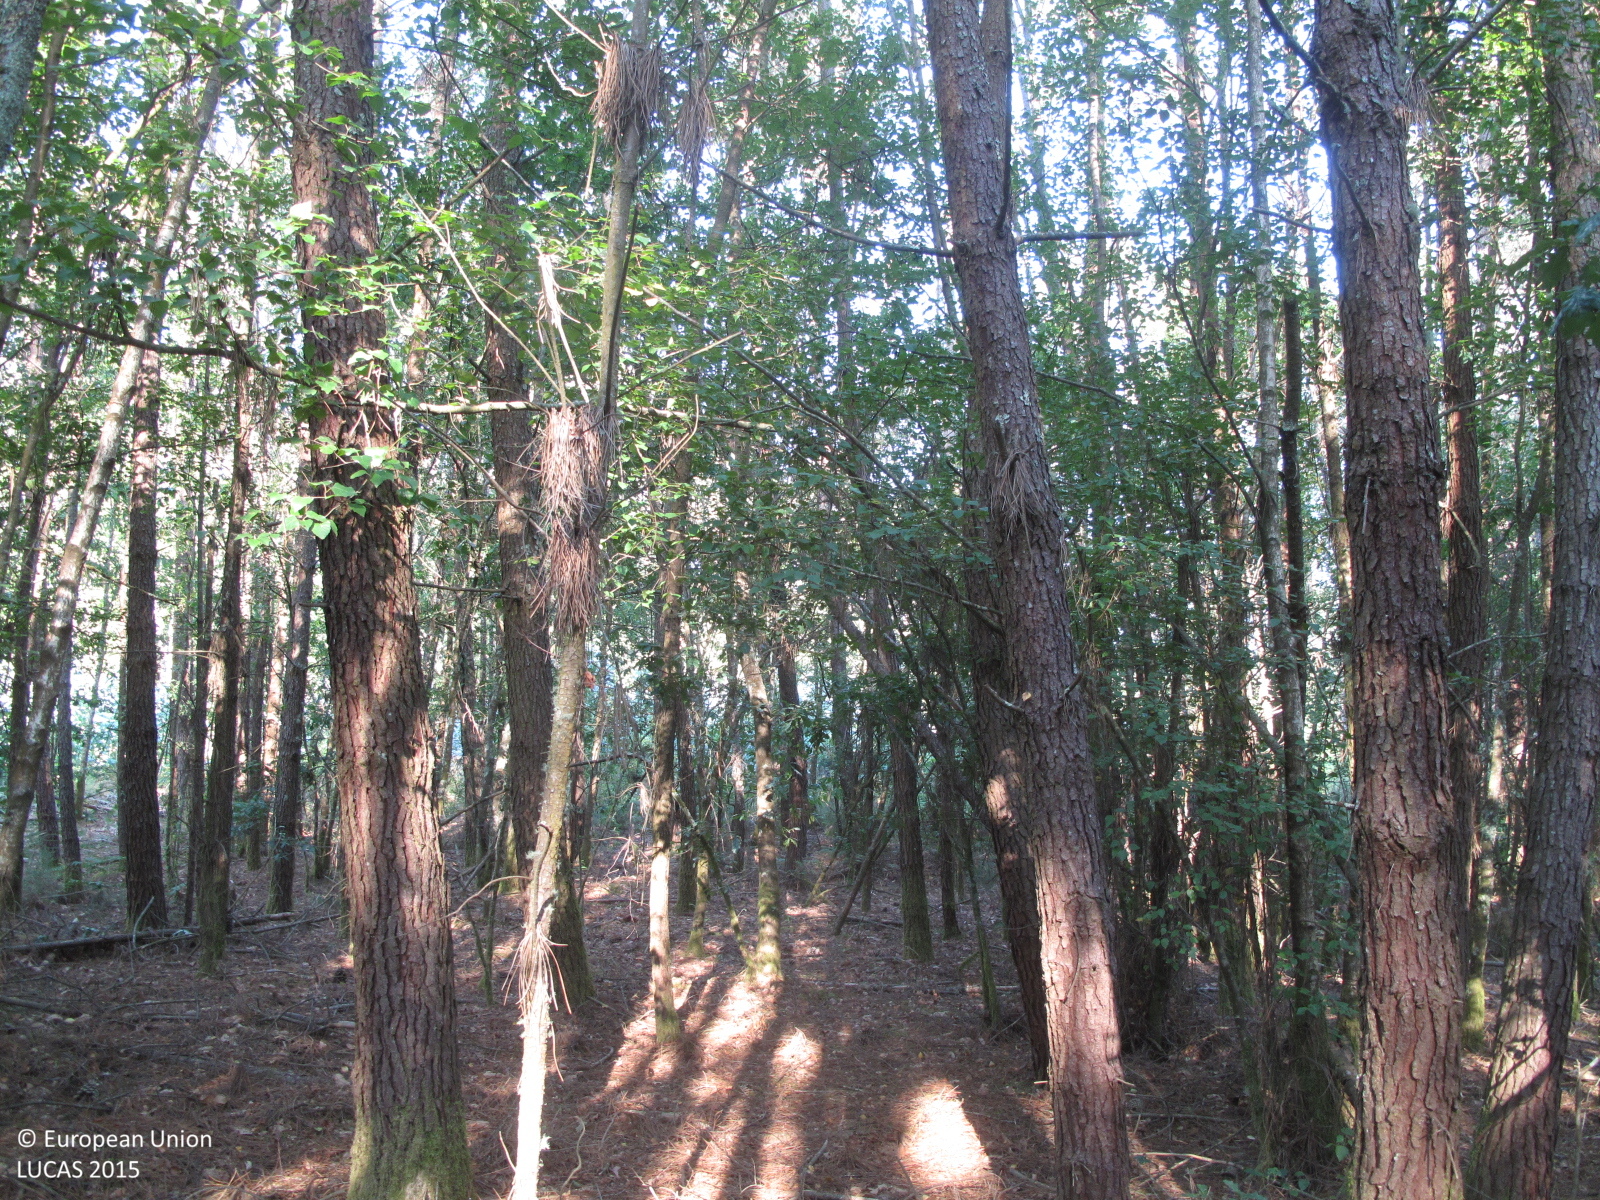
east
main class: Woodland
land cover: Other mixed woodland
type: acidophilous oak and oak-birch forest
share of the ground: > 75 %
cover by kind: broadleaved forest trees 50 %, coniferous forest trees 30 %, shrubs 10 %, unconsolidated bare surface 10 %
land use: Forestry
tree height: > 5 m
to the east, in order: Other mixed woodland; Tracks; Other mixed woodland; Grassland without tree/shrub cover
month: July
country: ES
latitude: 43.3387
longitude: -8.0678
